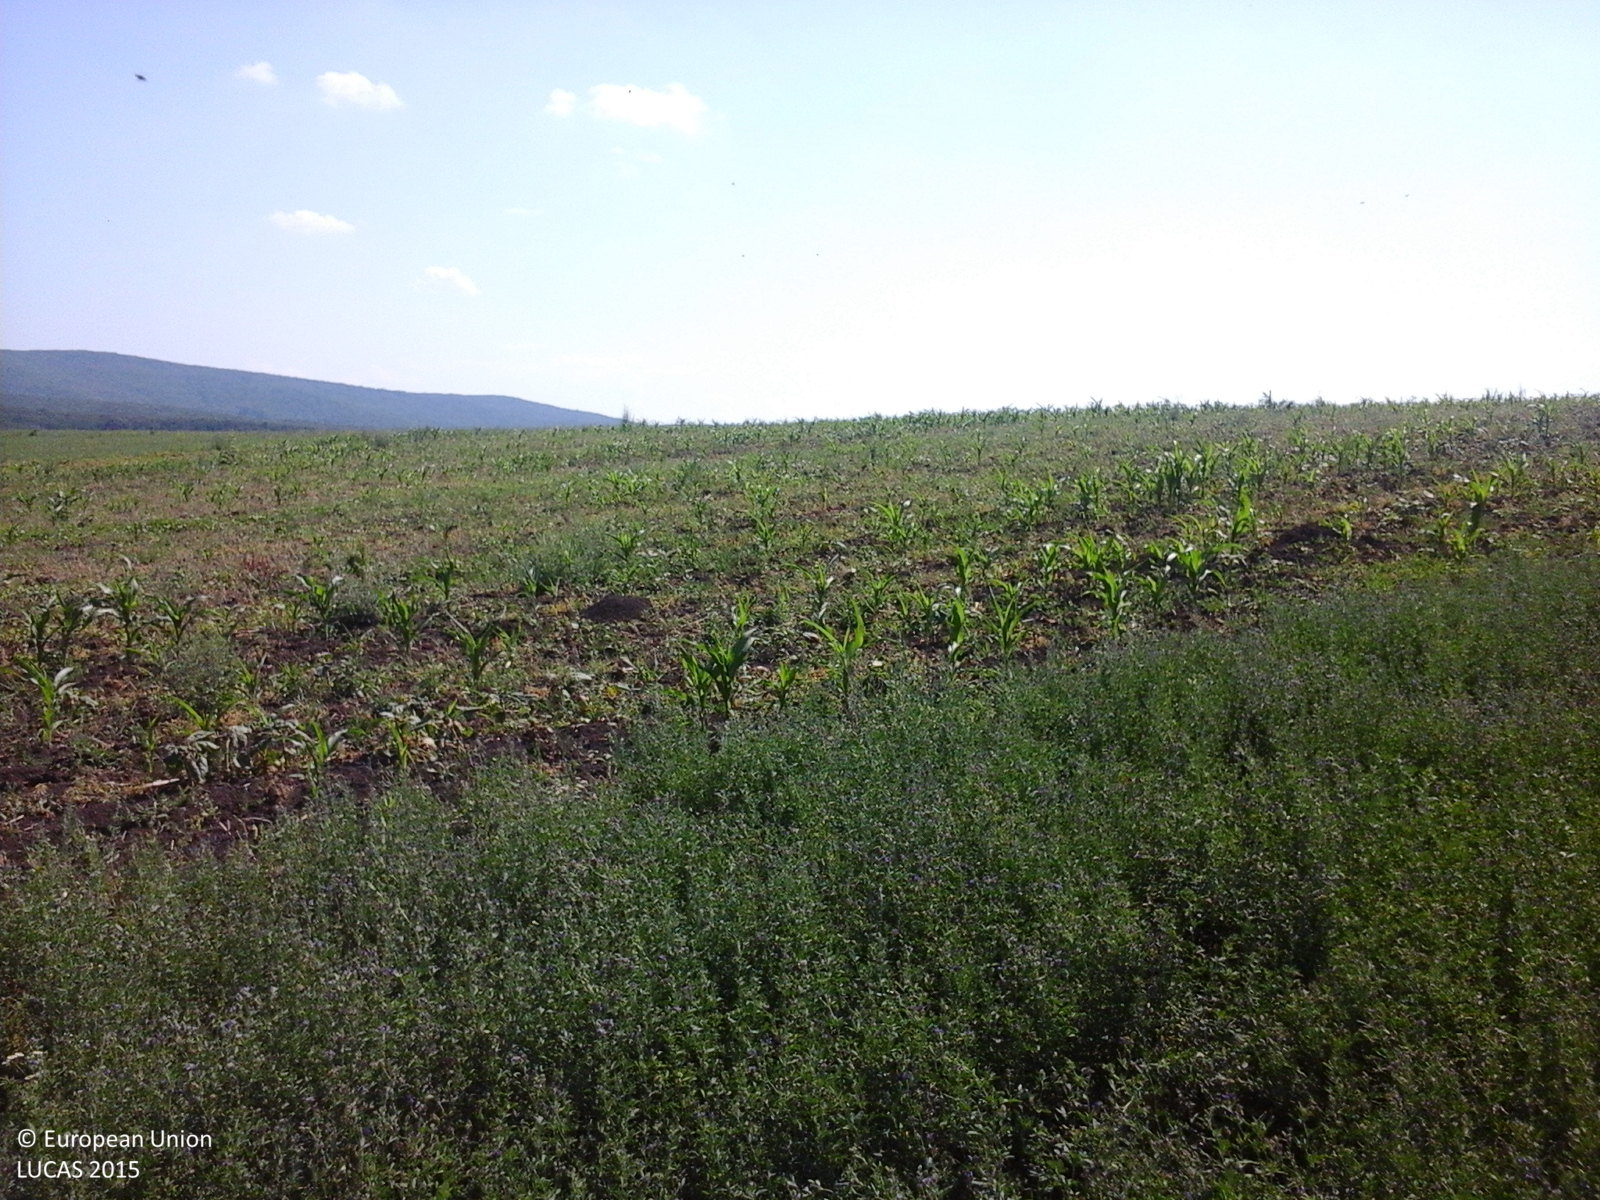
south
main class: Cropland
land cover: Lucerne
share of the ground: > 75 %
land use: Agriculture (excluding fallow land and kitchen gardens)
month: June
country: RO
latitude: 47.1246
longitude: 27.2576
